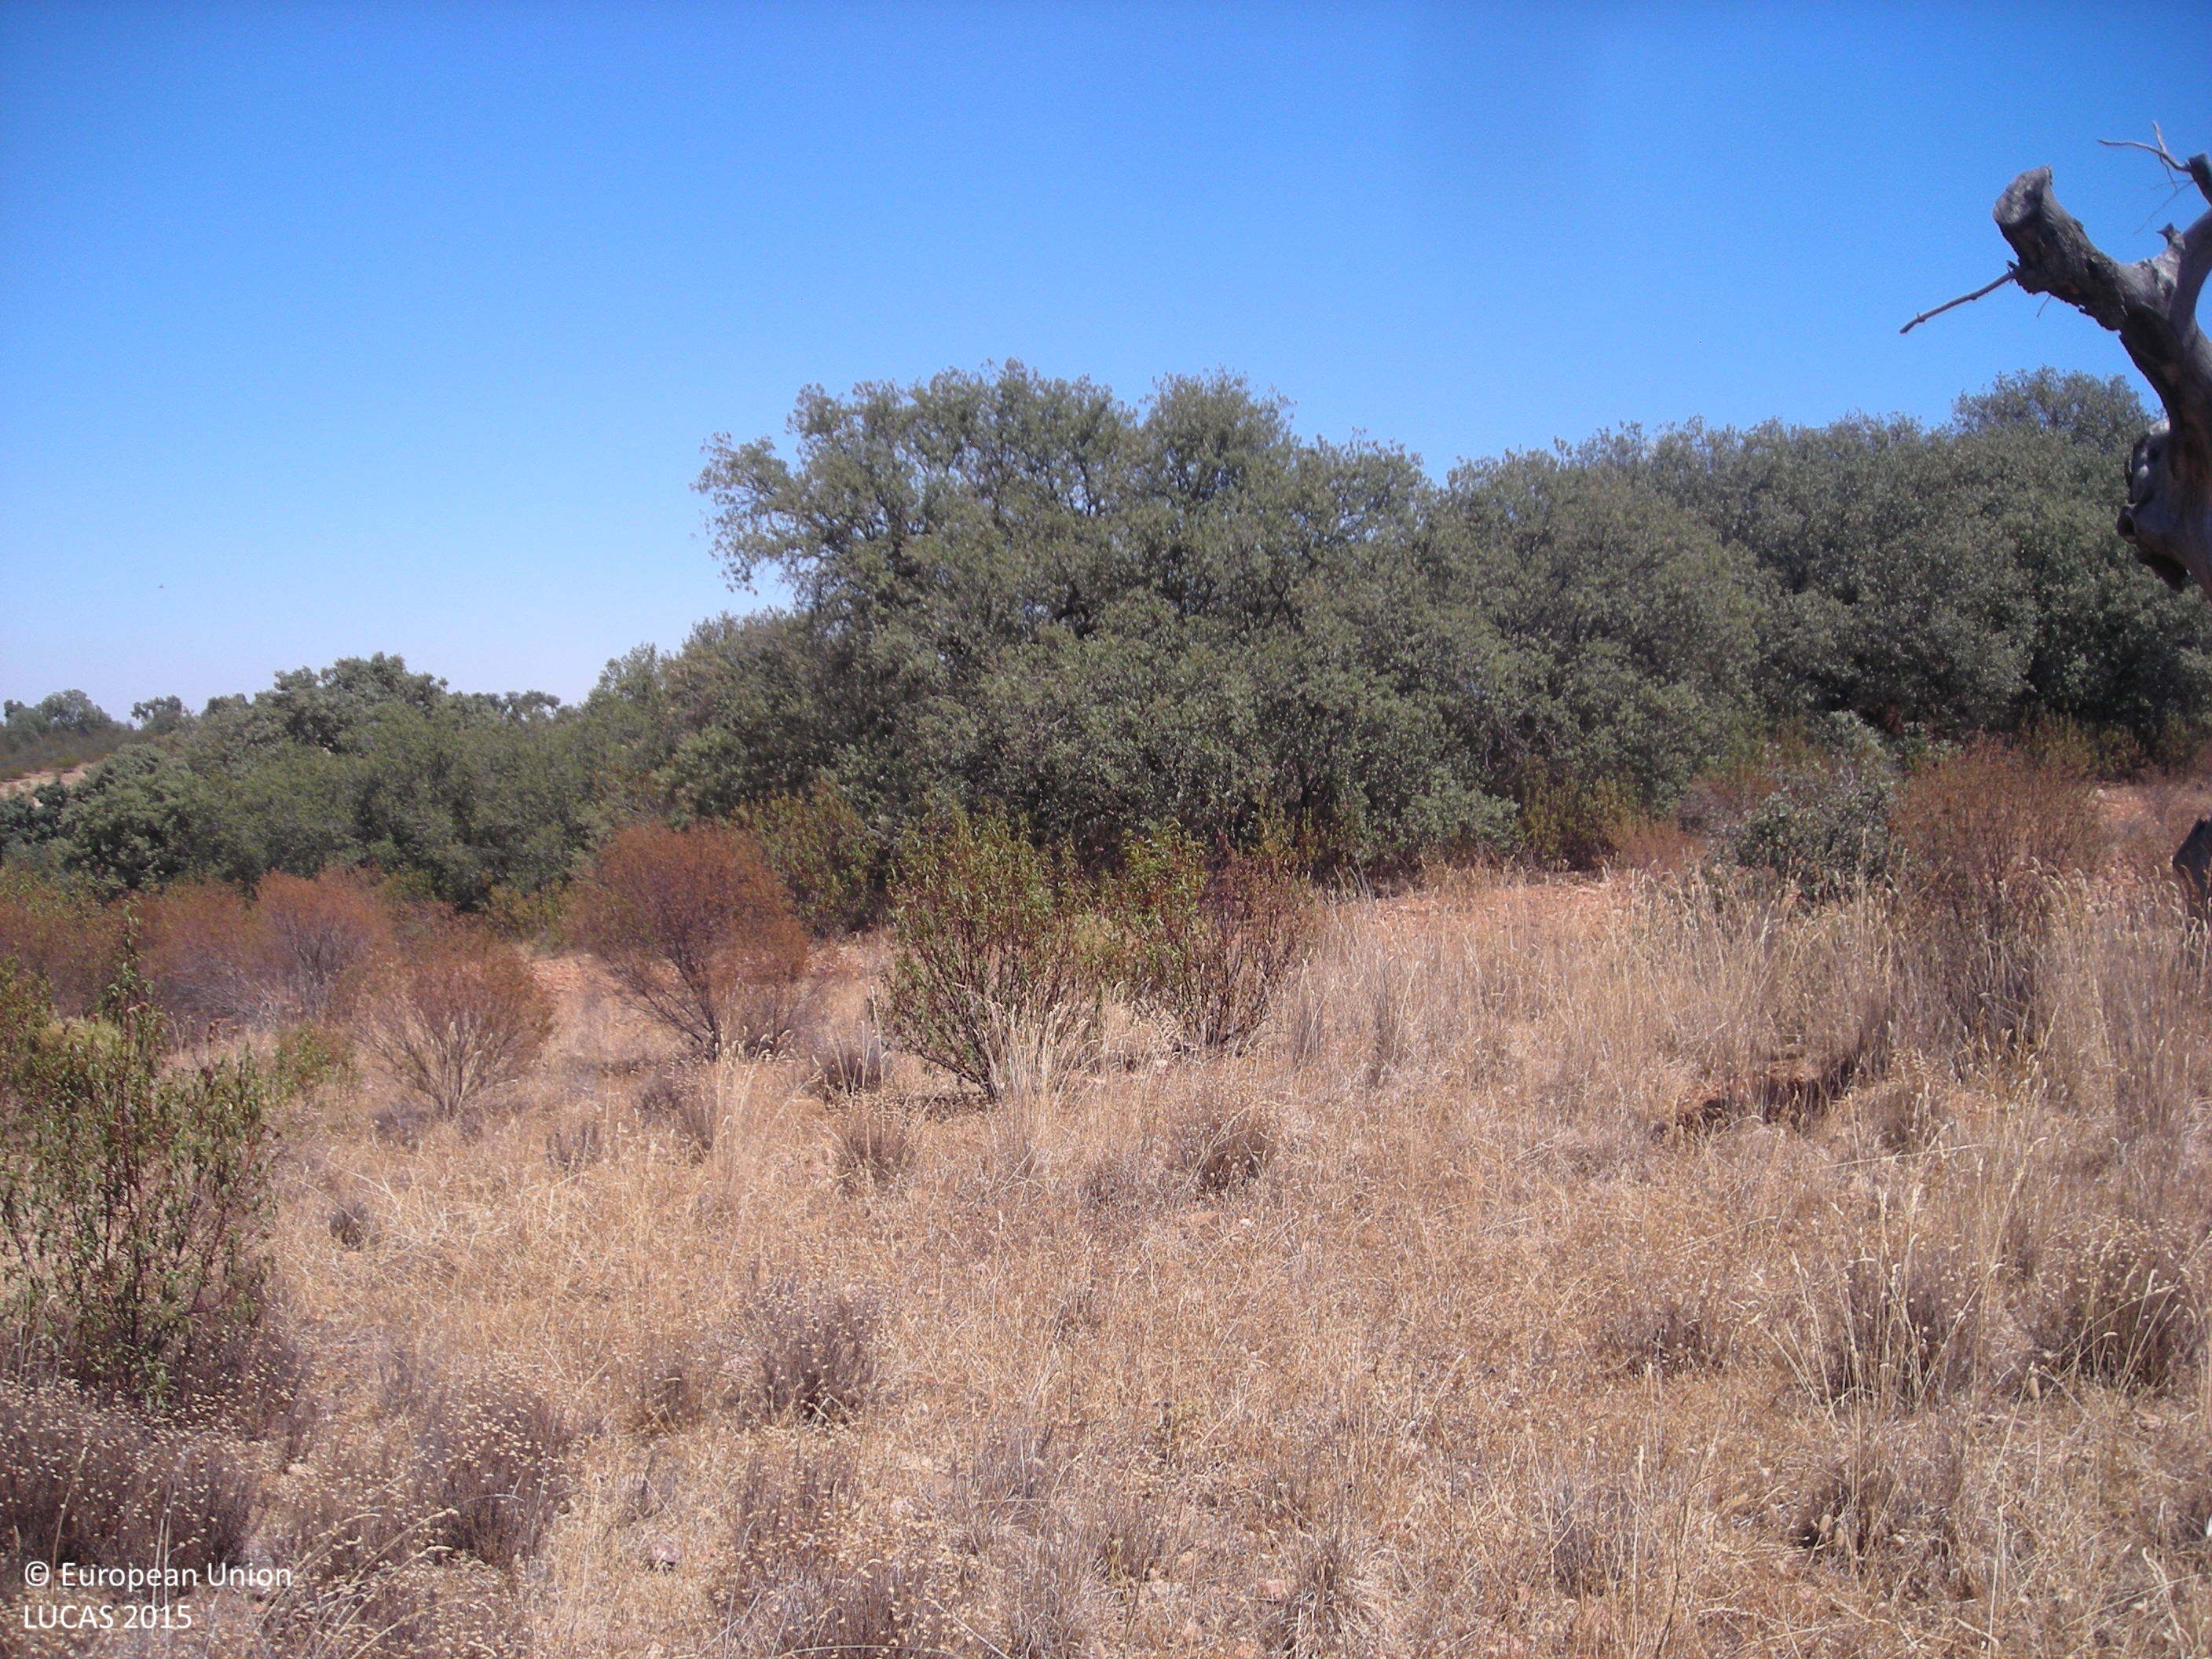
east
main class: Shrubland
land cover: Shrubland with sparse tree cover
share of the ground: > 75 %
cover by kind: shrubs 95 %, broadleaved forest trees 5 %
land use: Semi-natural and natural areas not in use
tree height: > 5 m
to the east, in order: Shrubland with sparse tree cover; Tracks; Shrubland without tree cover; Tracks; Shrubland without tree cover; Tracks; Broadleaved woodland
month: July
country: ES
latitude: 38.8104
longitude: -5.8114
